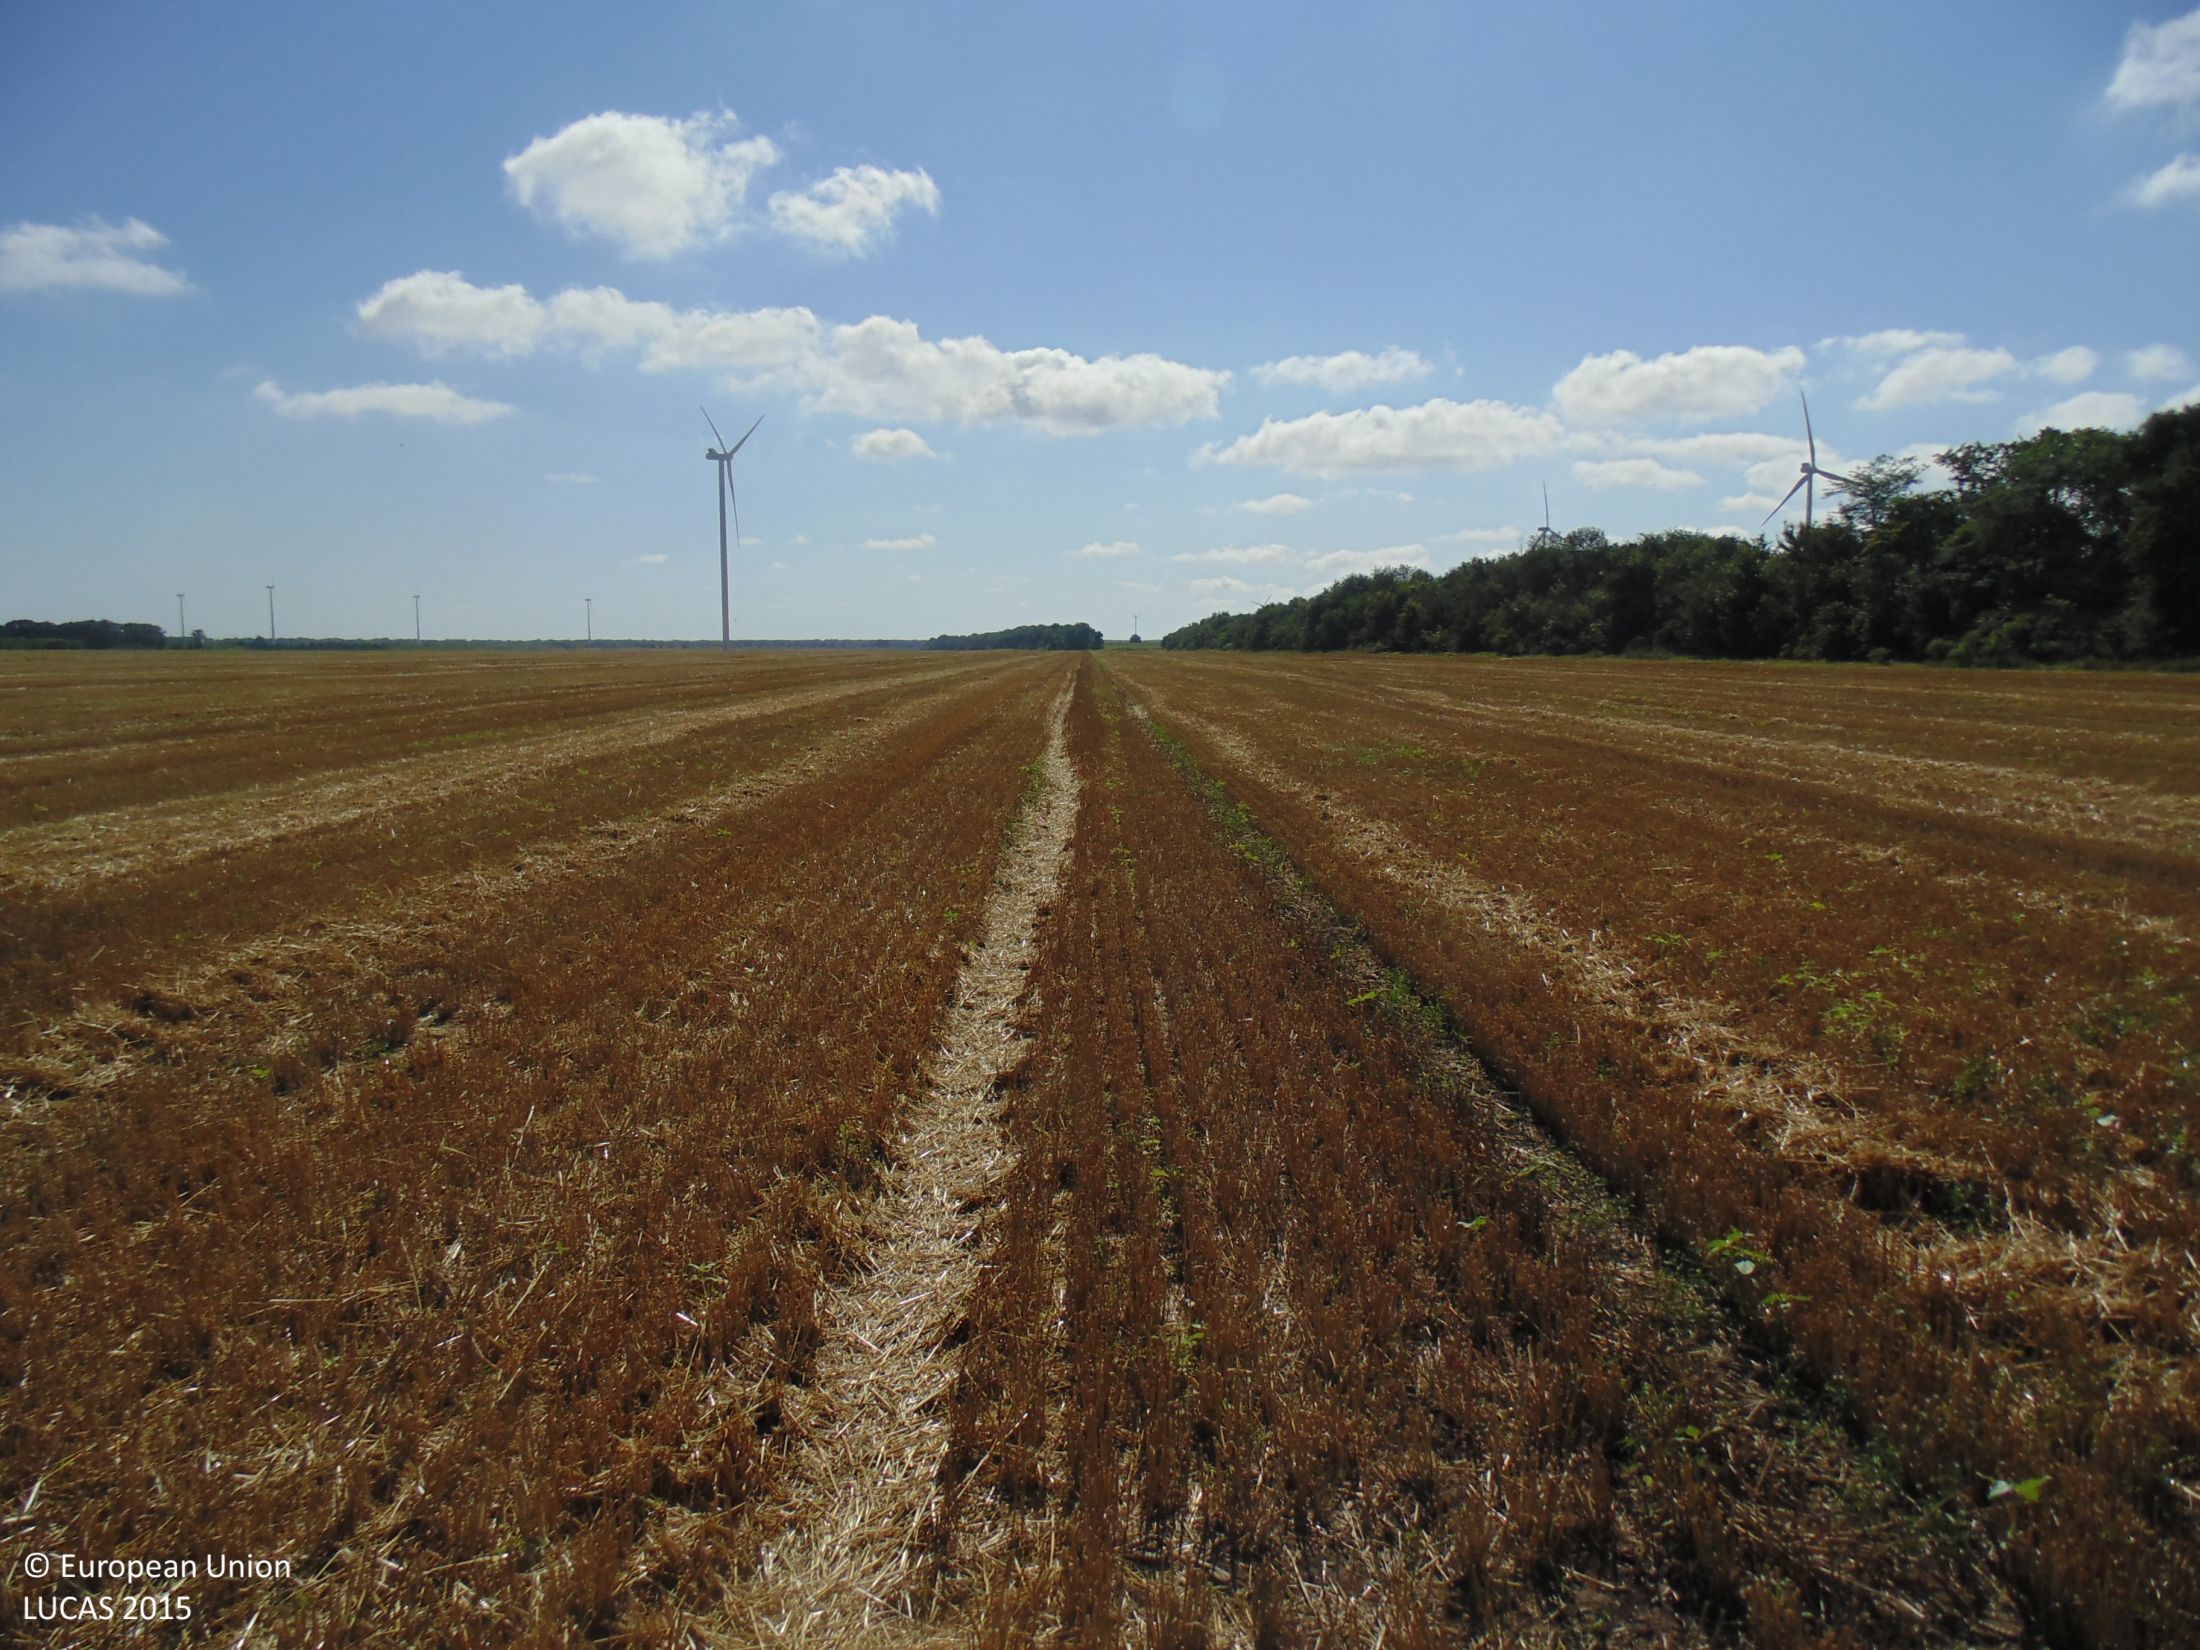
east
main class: Cropland
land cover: Common wheat
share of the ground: 10 - 25 %
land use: Agriculture (excluding fallow land and kitchen gardens)
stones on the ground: < 10 %
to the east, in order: Common wheat
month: July
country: BG
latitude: 43.4475
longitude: 27.9749
